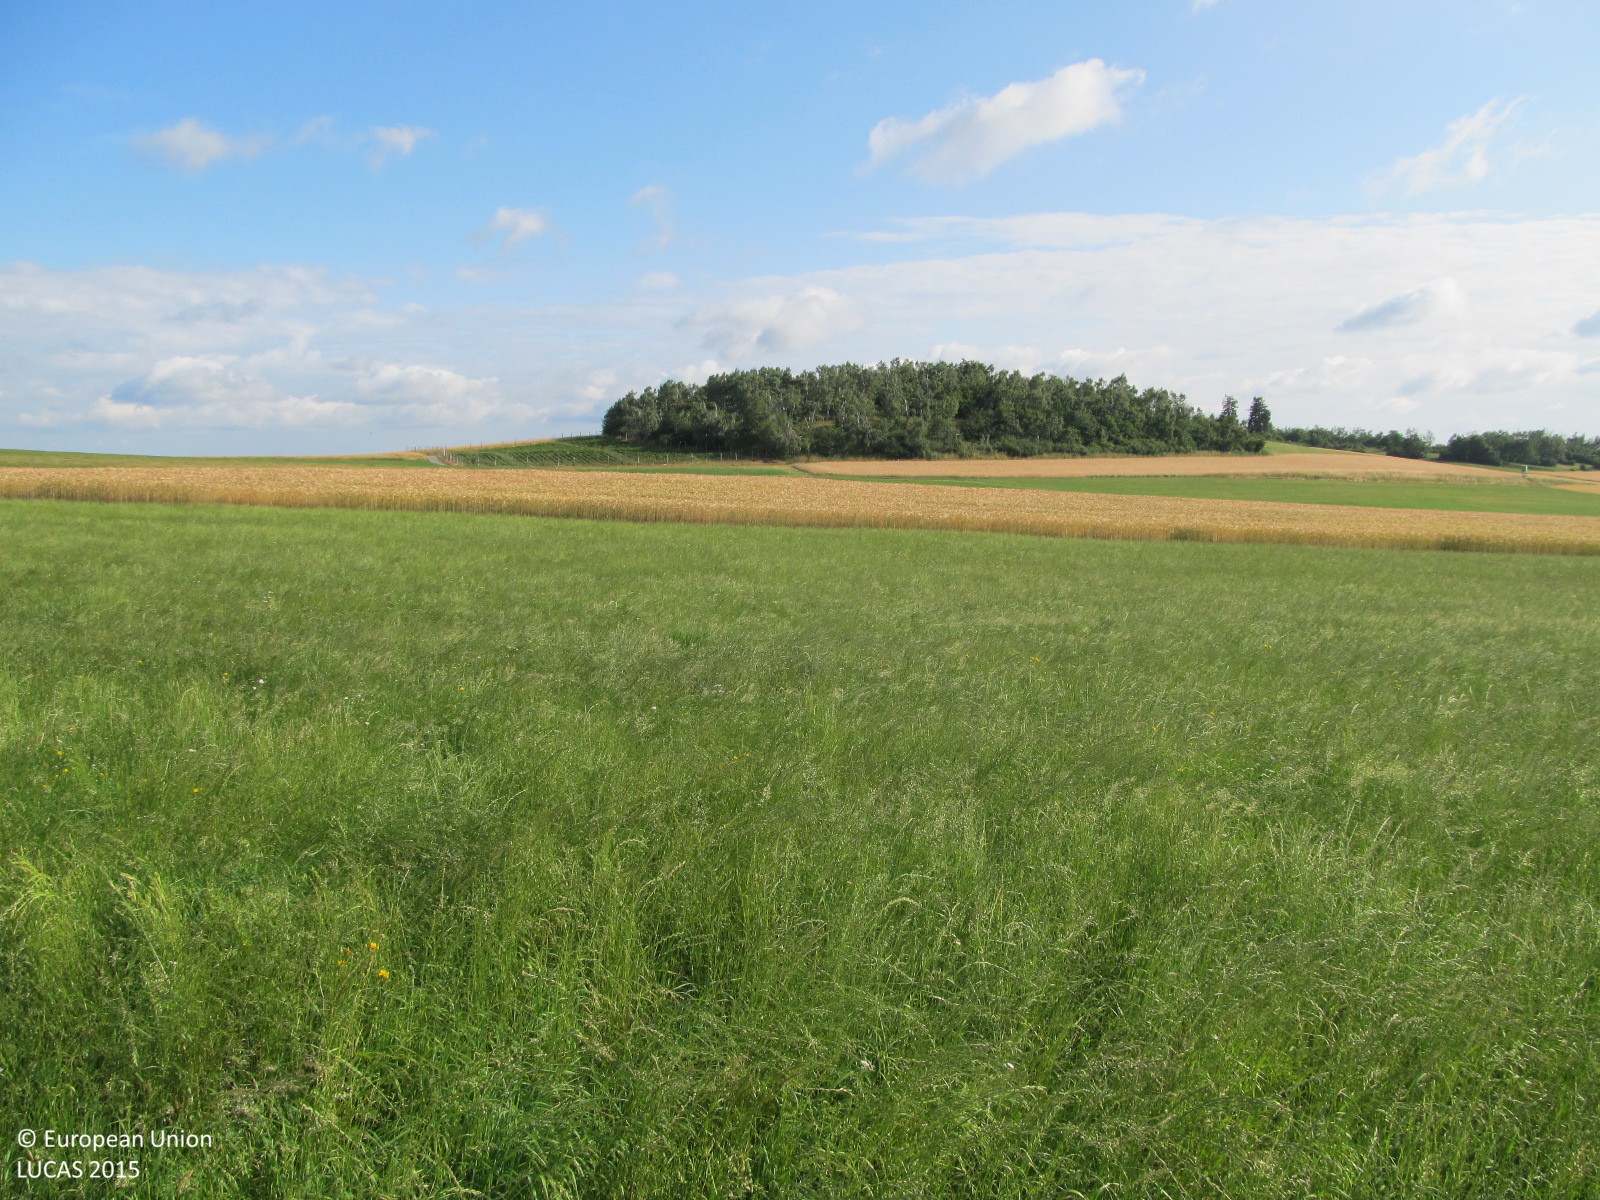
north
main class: Grassland
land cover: Grassland without tree/shrub cover
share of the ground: > 75 %
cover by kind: herbaceous plants 100 %
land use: Agriculture (excluding fallow land and kitchen gardens)
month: July
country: AT
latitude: 48.4162
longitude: 15.3934
